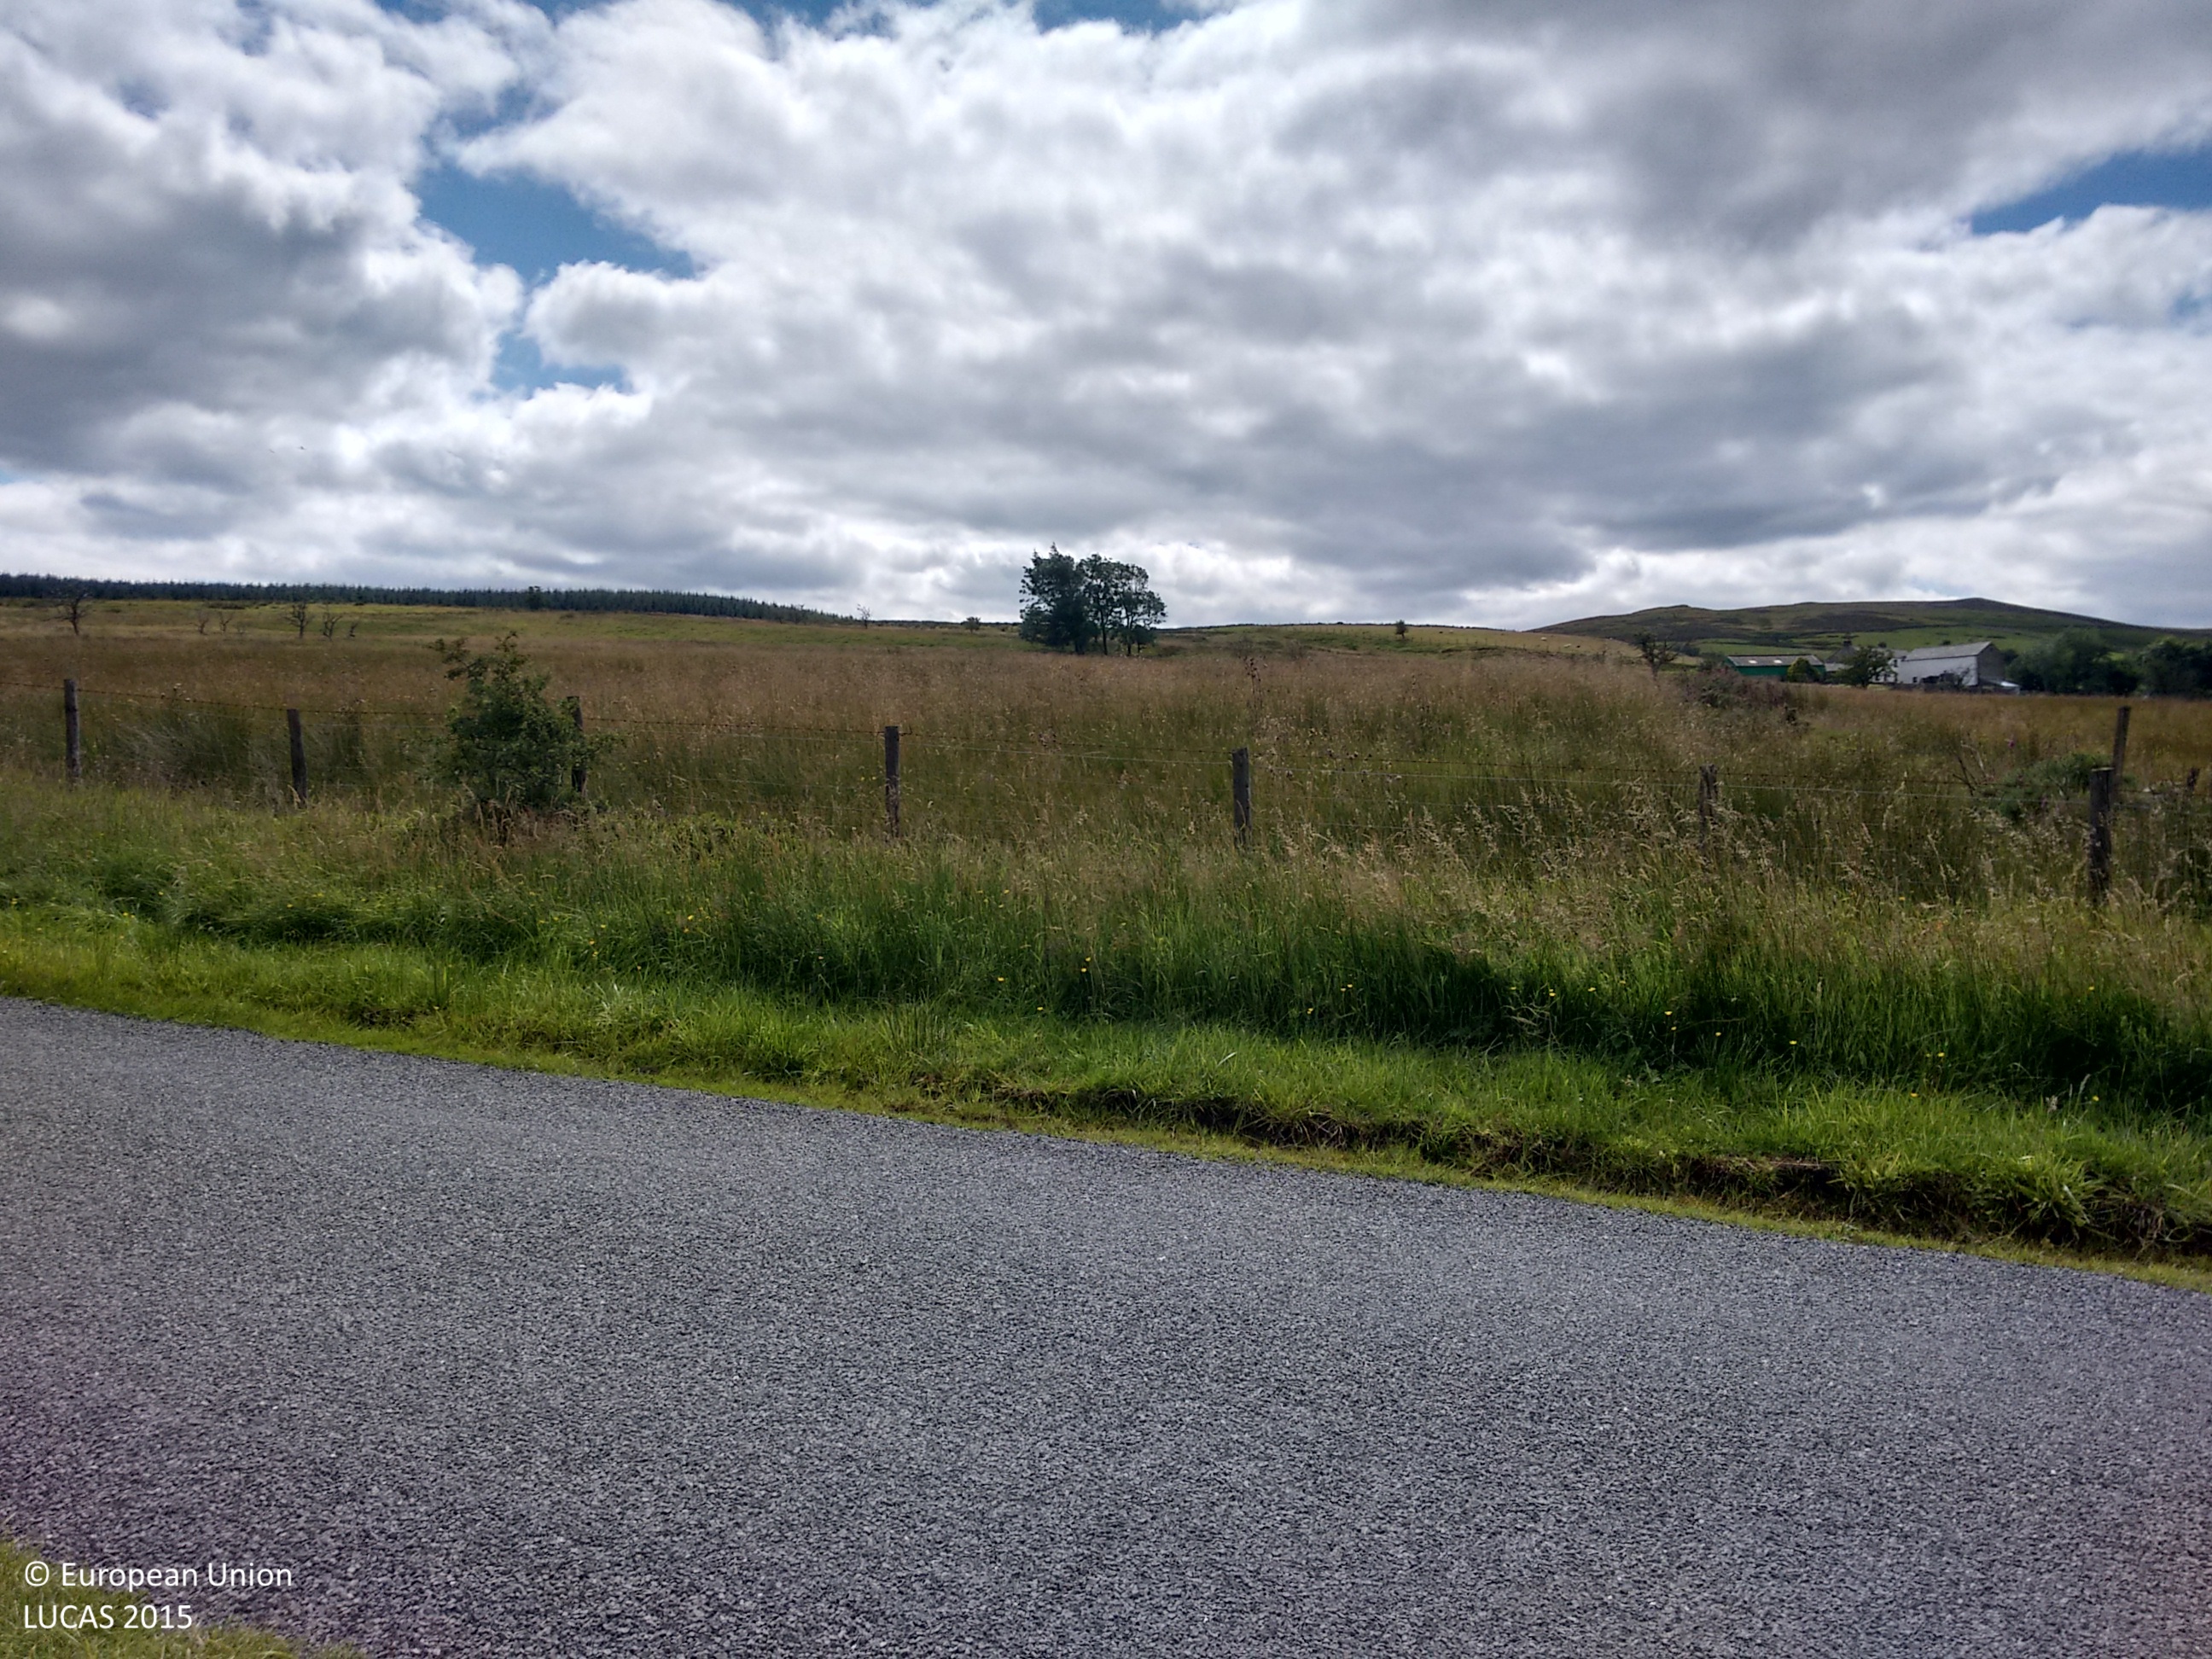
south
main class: Grassland
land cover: Grassland without tree/shrub cover
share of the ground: > 75 %
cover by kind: herbaceous plants 100 %
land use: Agriculture (excluding fallow land and kitchen gardens)
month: August
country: GB
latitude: 54.6030
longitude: -2.9037
